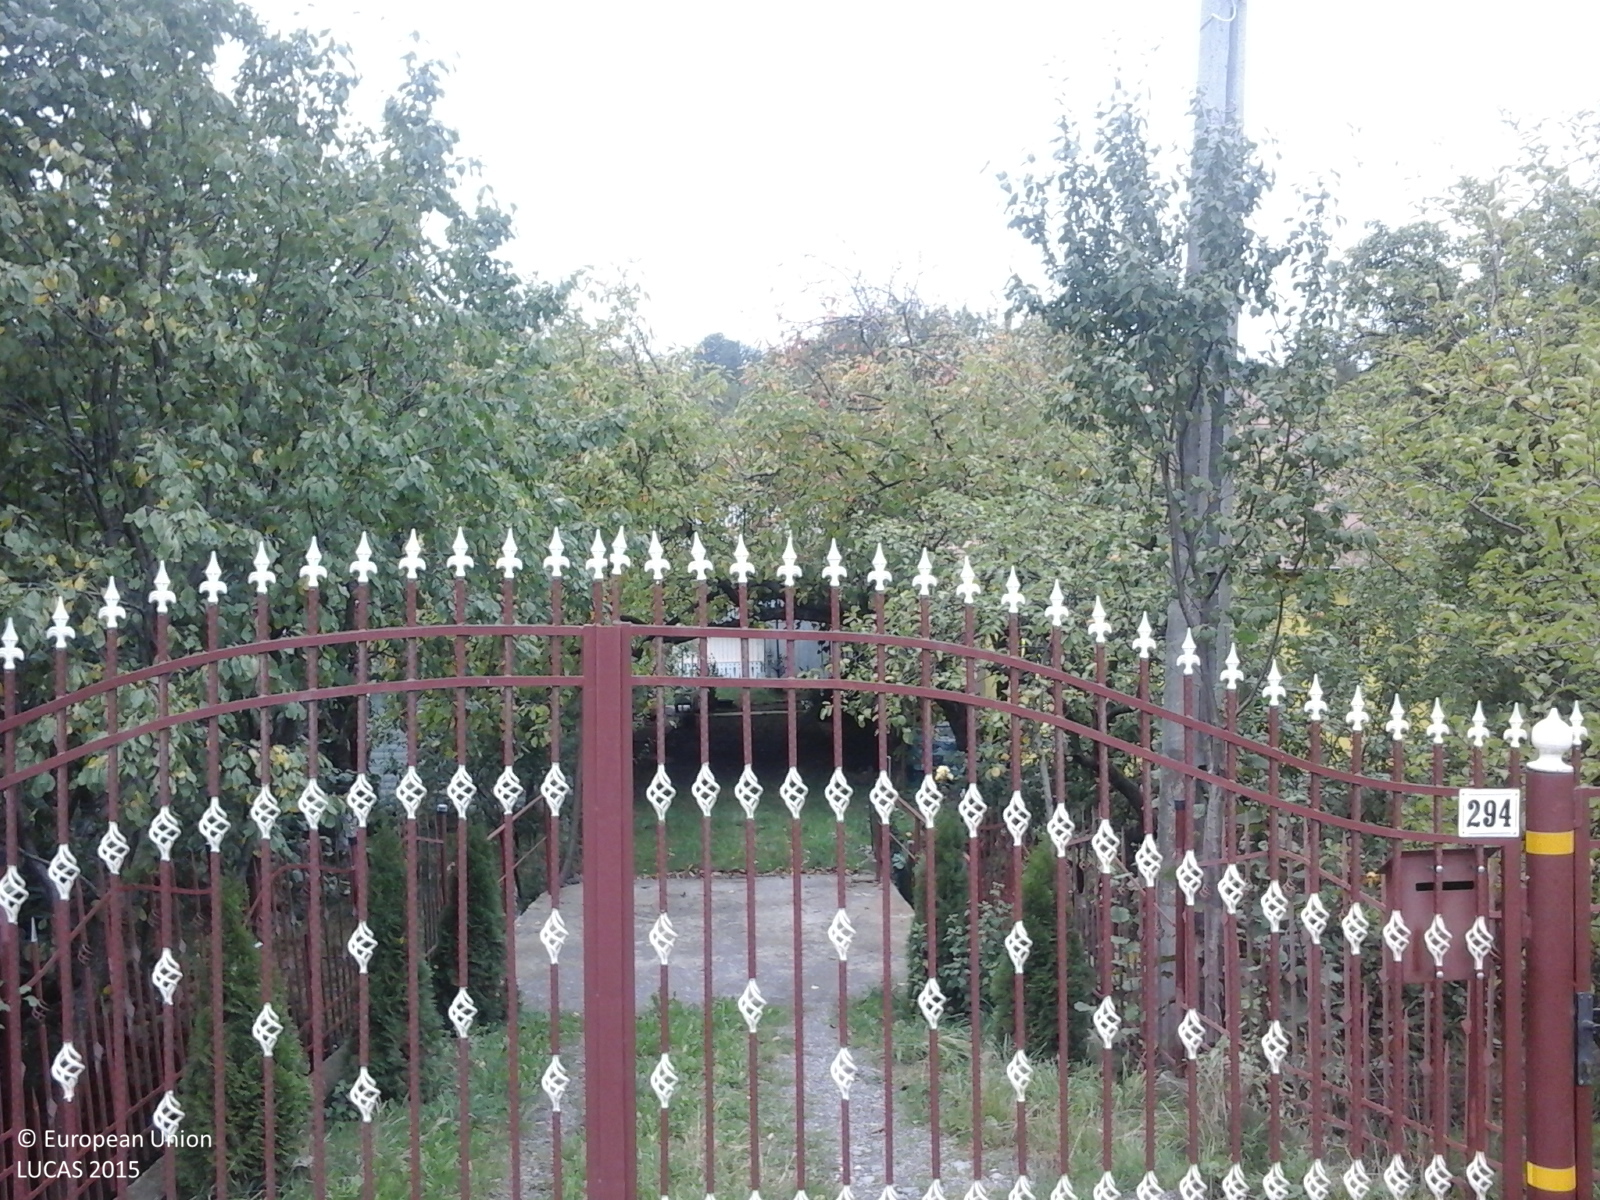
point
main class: Cropland
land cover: Apple fruit
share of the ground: > 75 %
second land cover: Grassland without tree/shrub cover
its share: > 75 %
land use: Agriculture (excluding fallow land and kitchen gardens)
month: October
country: RO
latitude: 46.8092
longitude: 24.9728
